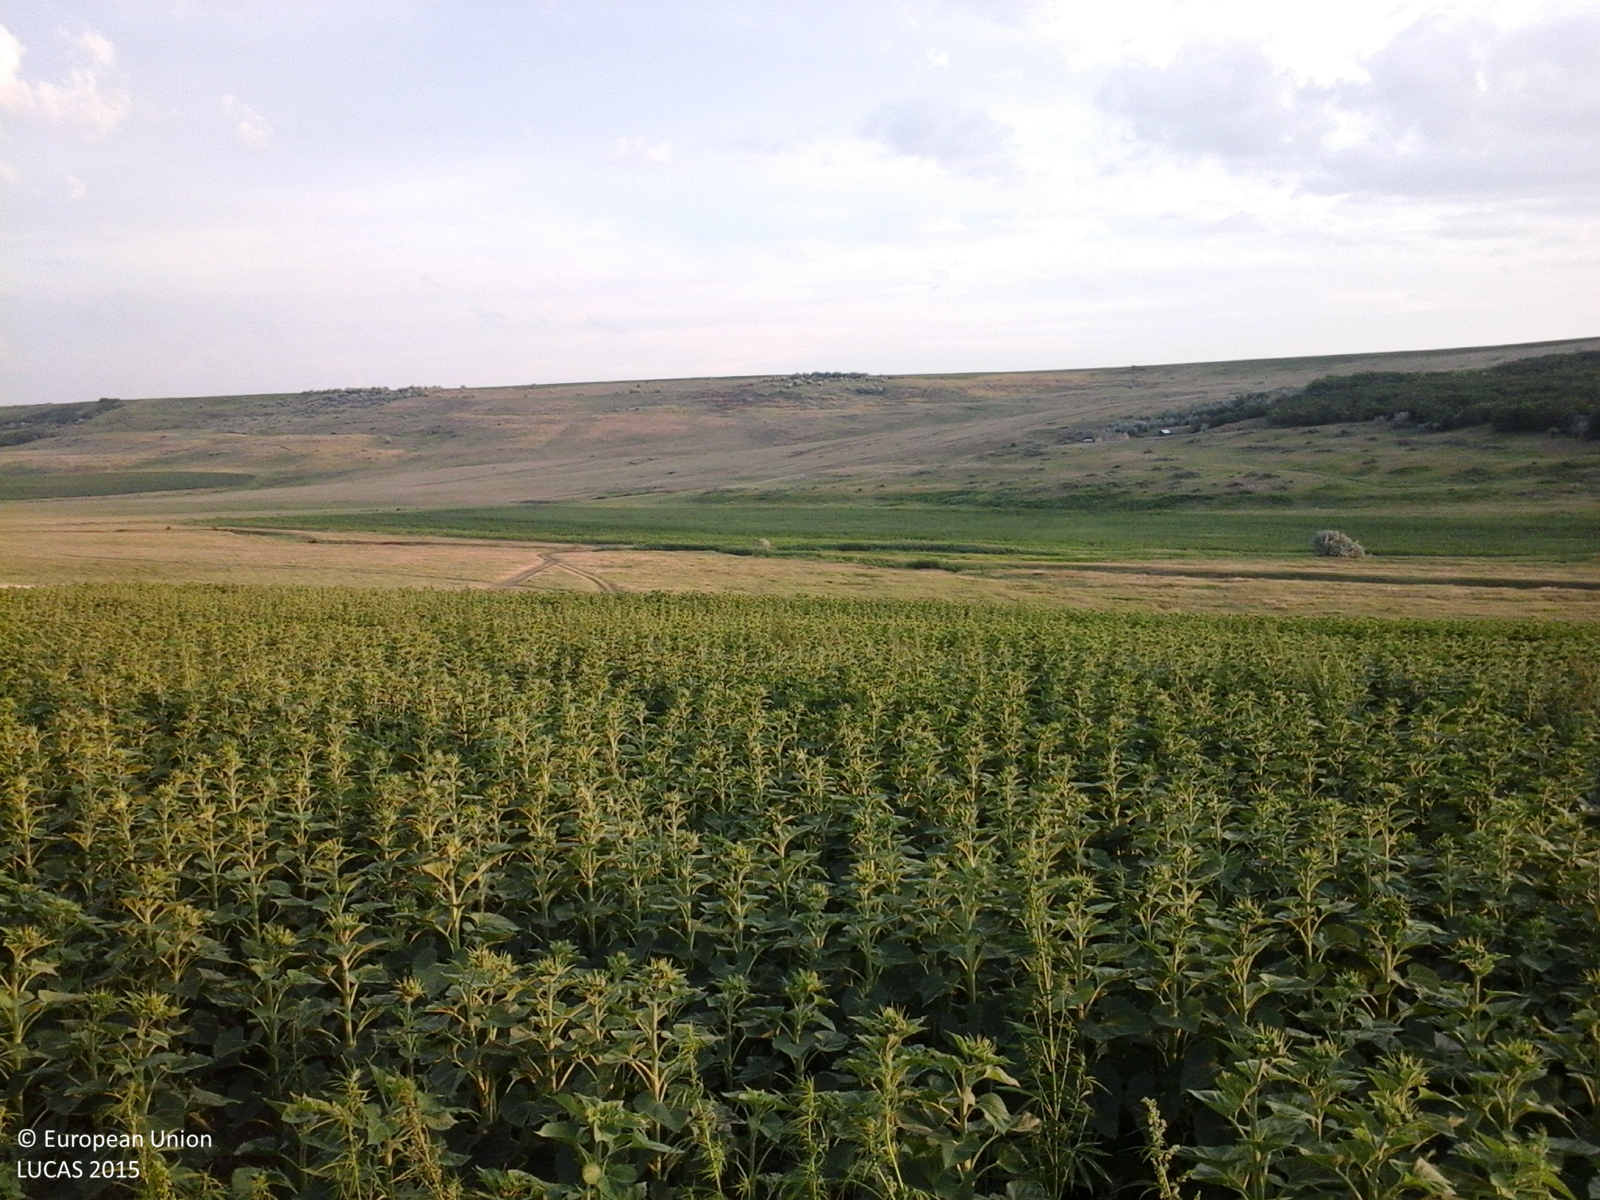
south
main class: Grassland
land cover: Spontaneously vegetated surfaces
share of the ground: > 75 %
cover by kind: herbaceous plants 100 %
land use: Fallow land
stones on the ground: < 10 %
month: June
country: RO
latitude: 46.7489
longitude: 28.0774
